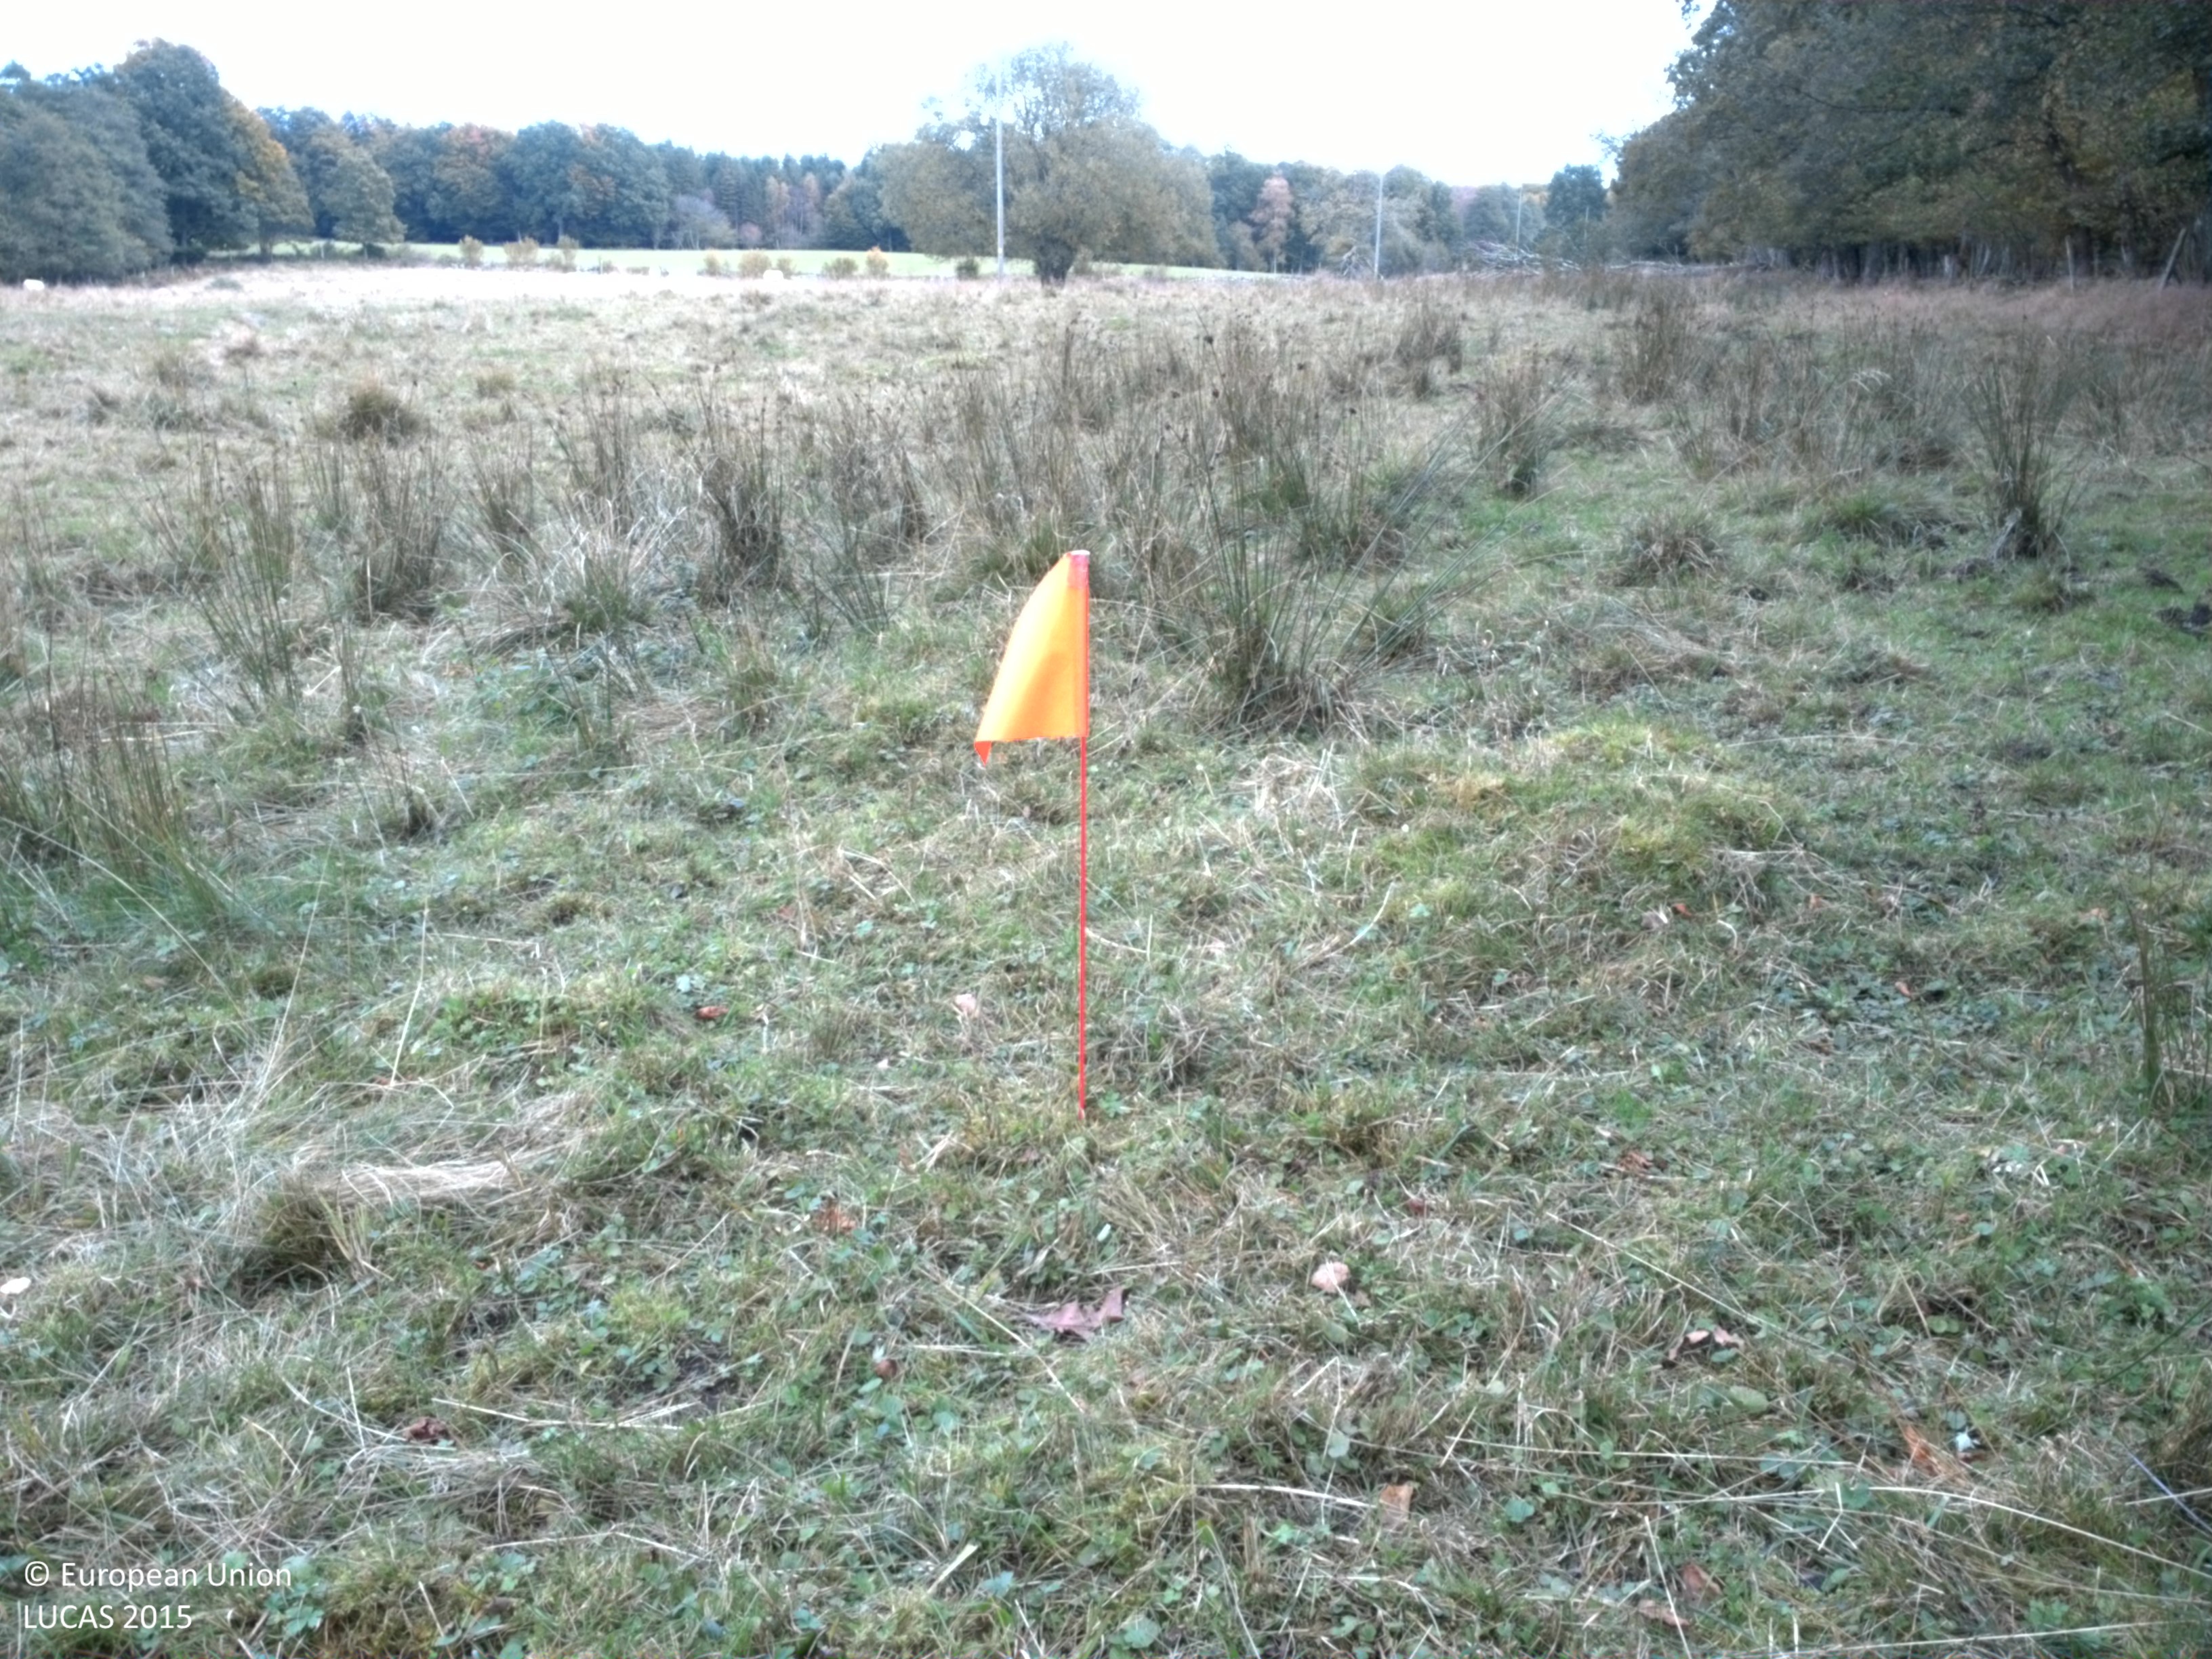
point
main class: Grassland
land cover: Grassland without tree/shrub cover
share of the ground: > 75 %
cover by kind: herbaceous plants 100 %
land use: Agriculture (excluding fallow land and kitchen gardens)
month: October
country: SE
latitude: 55.6918
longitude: 14.0549
